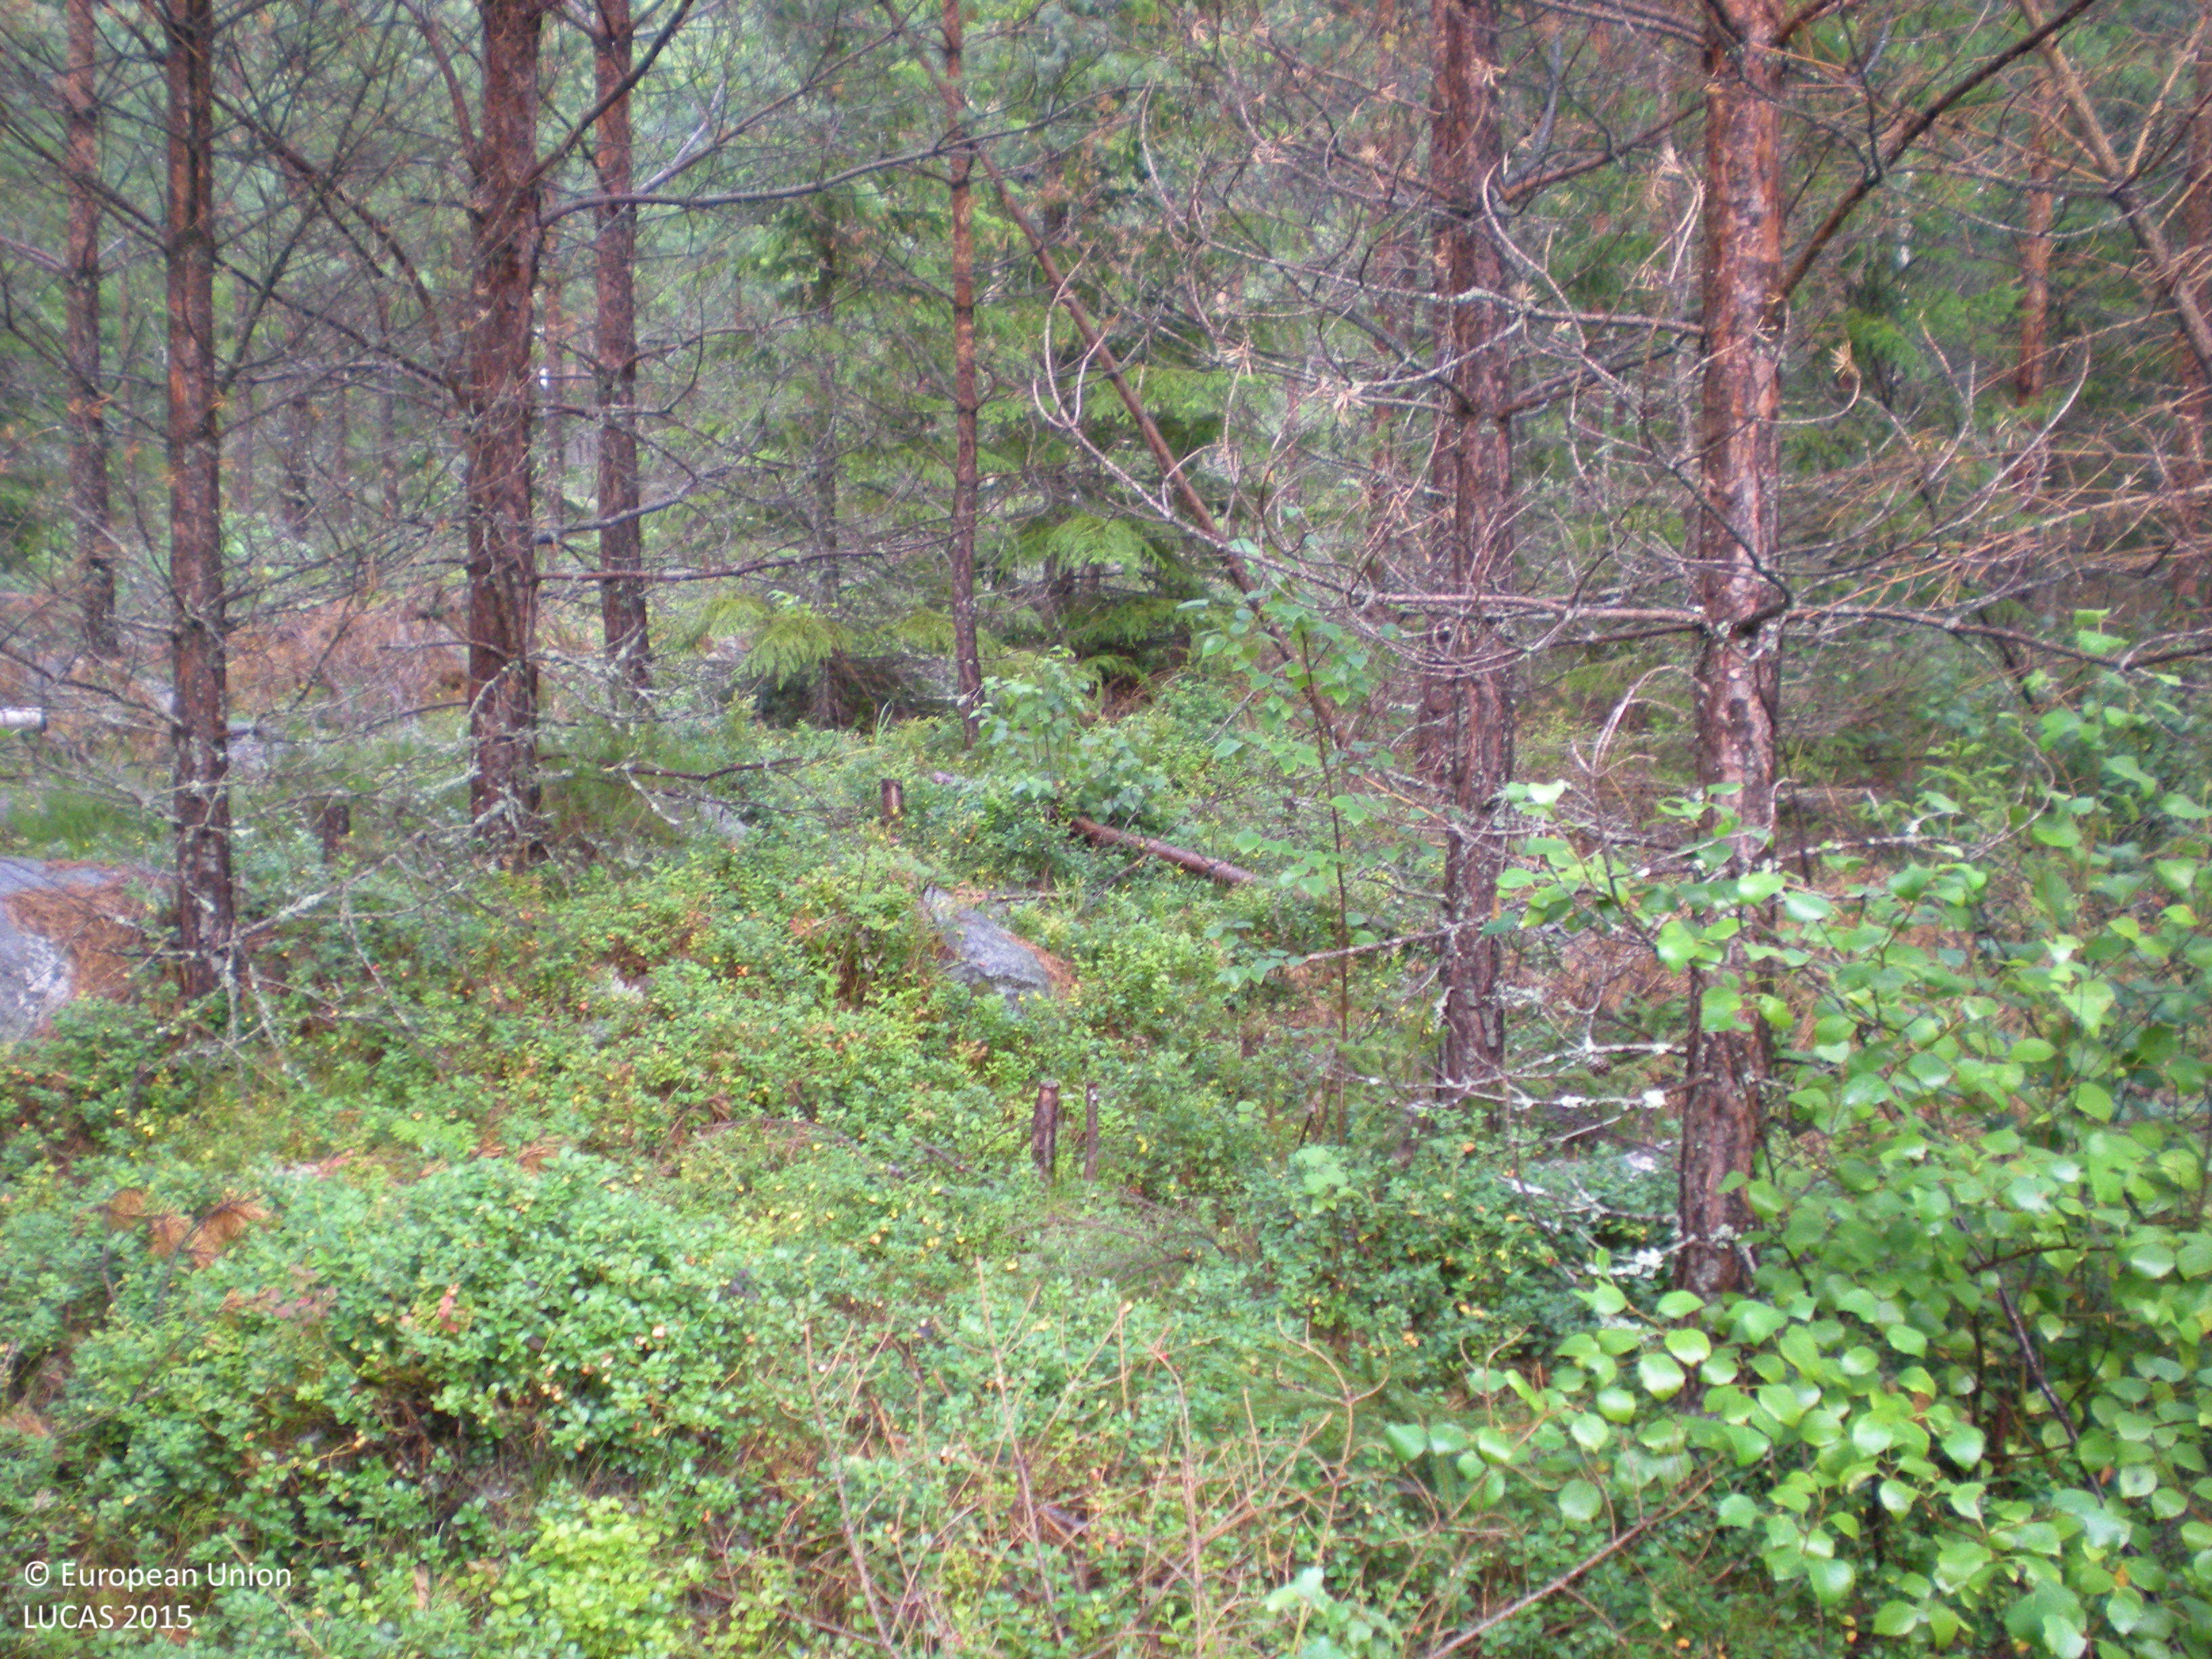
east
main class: Woodland
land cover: Pine dominated coniferous woodland
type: boreal forest
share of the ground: 50 - 75 %
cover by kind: coniferous forest trees 65 %, shrubs 15 %, broadleaved forest trees 5 %, herbaceous plants 5 %, lichens and mosses 5 %, consolidated bare surface 5 %
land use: Forestry
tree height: < 5 m
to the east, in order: Pine dominated coniferous woodland; Other coniferous woodland; Pine dominated coniferous woodland; Tracks; Pine dominated coniferous woodland
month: August
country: SE
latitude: 60.7349
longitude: 17.2694
